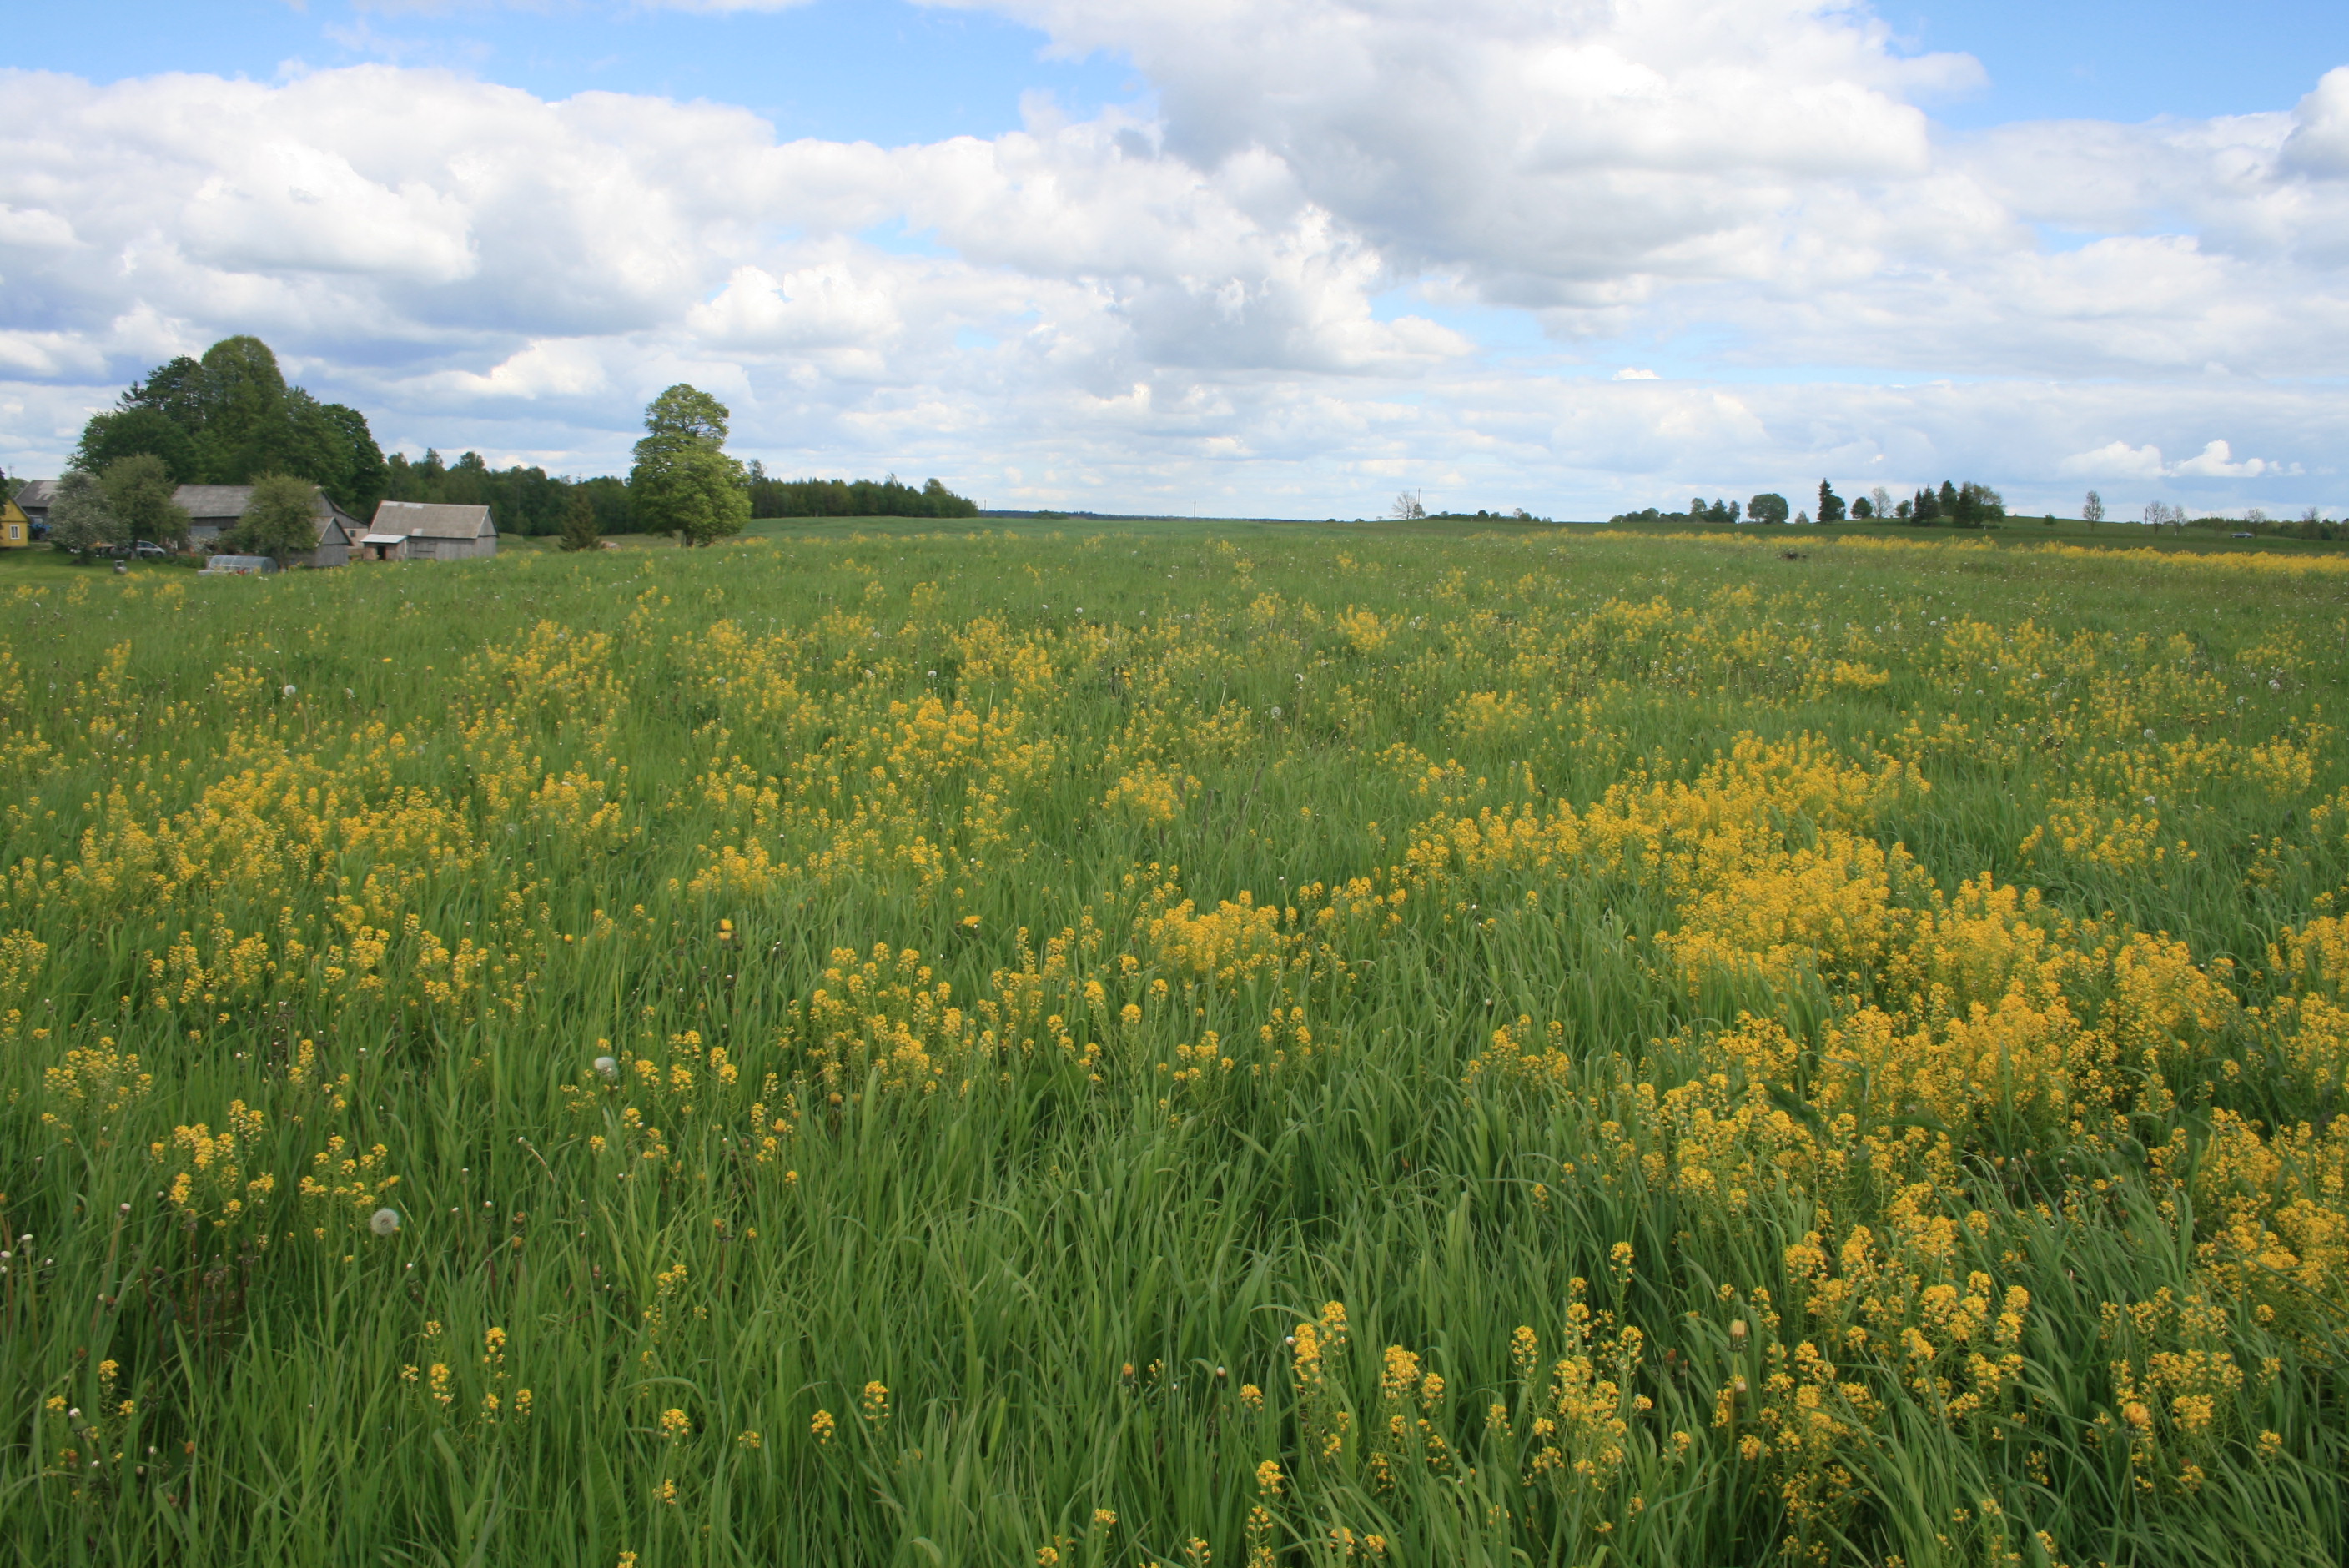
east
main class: Cropland
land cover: Other leguminous and mixtures for fodder
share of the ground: > 75 %
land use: Agriculture (excluding fallow land and kitchen gardens)
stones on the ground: < 10 %
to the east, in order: Other leguminous and mixtures for fodder; Potatoes; Grass margins; Tracks; Grass margins; Fences; Grassland without tree/shrub cover
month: May
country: LT
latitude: 55.9838
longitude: 22.0247
